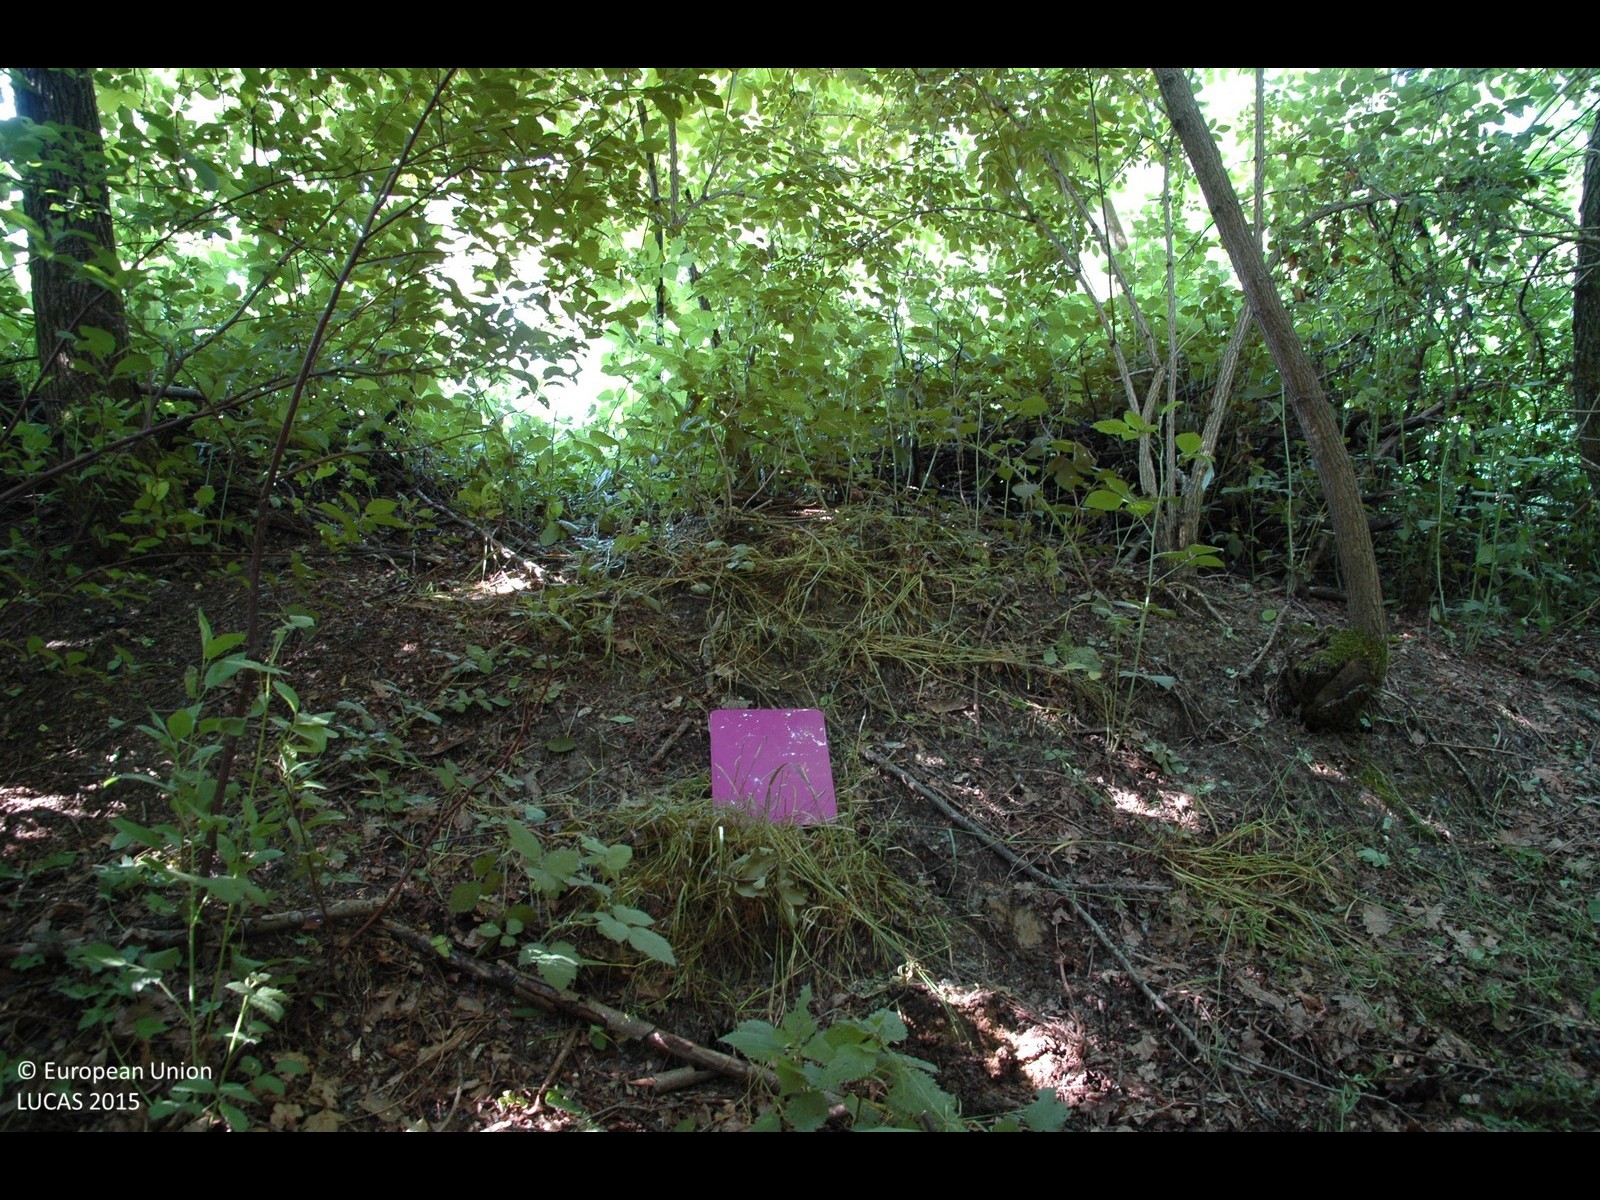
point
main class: Woodland
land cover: Broadleaved woodland
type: mesophytic deciduous forest
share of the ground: > 75 %
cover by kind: broadleaved forest trees 90 %, shrubs 5 %, herbaceous plants 5 %
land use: Forestry
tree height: > 5 m
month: May
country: HR
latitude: 46.4997
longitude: 16.4509
